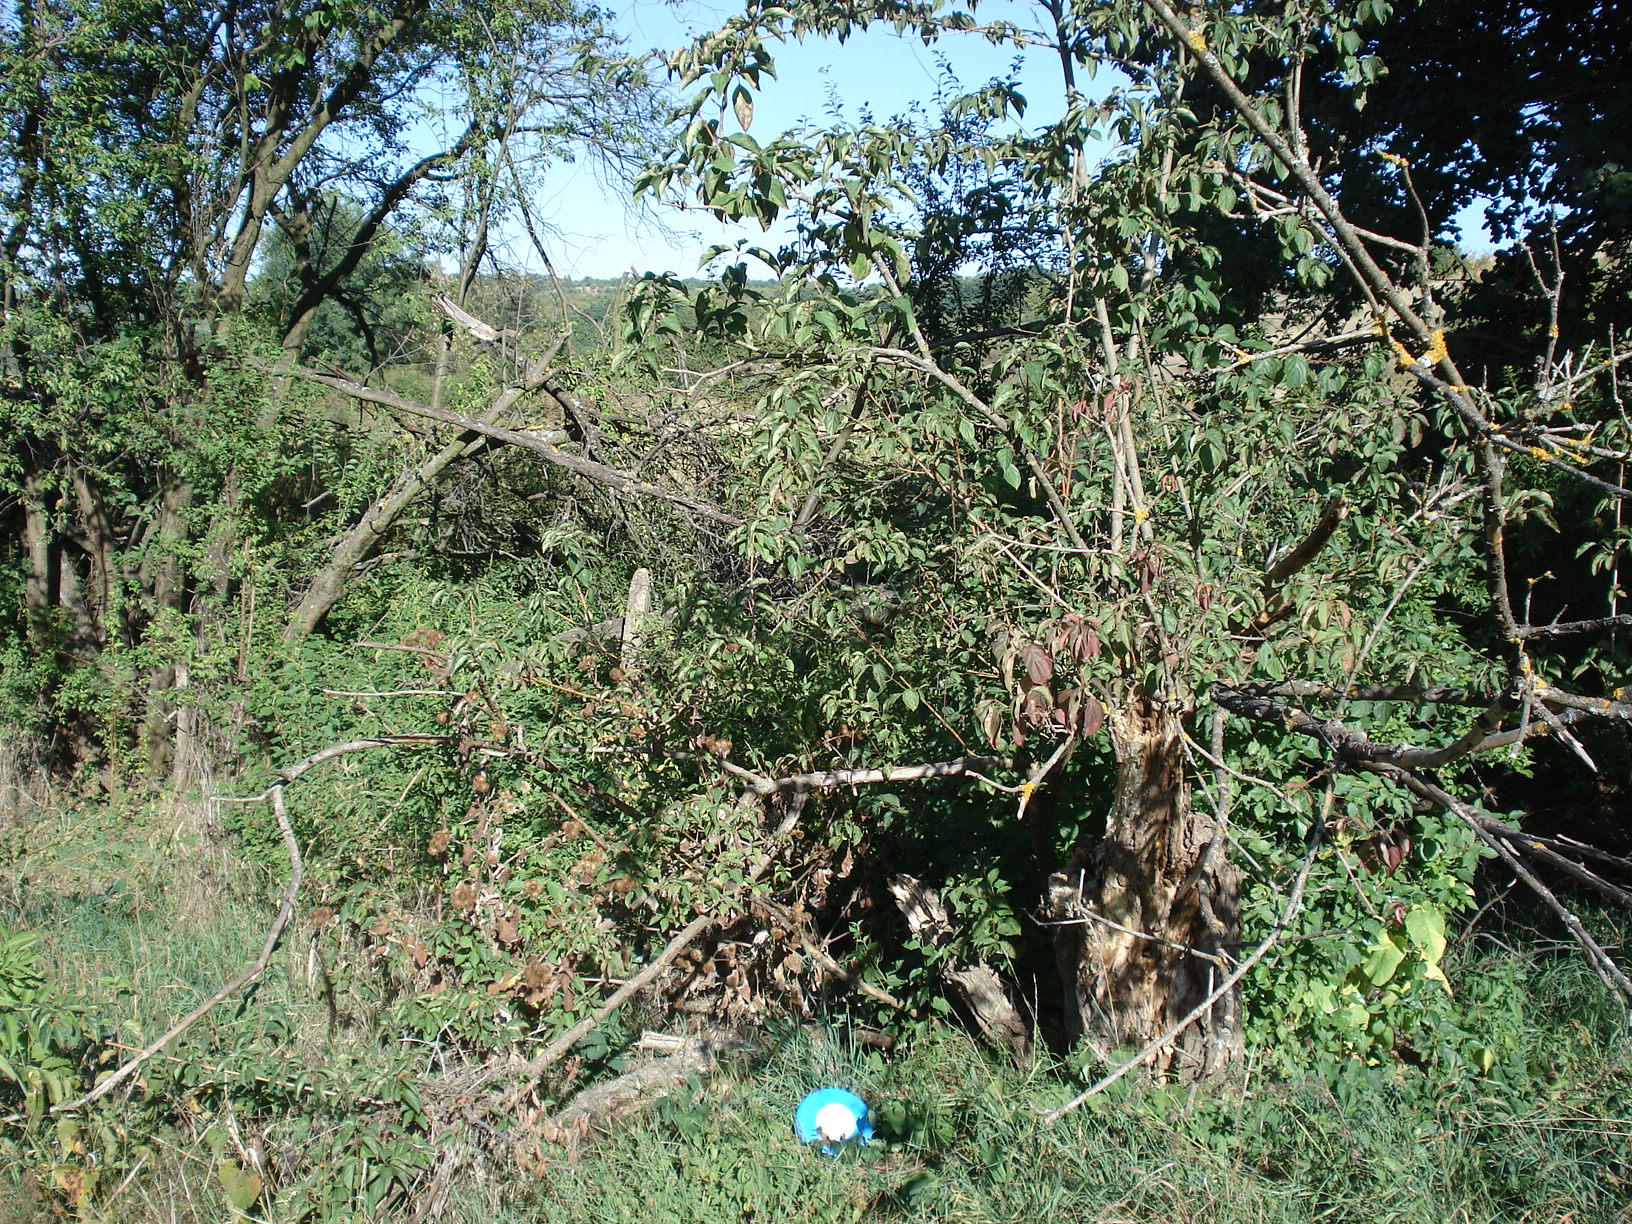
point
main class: Woodland
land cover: Broadleaved woodland
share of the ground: 50 - 75 %
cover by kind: broadleaved forest trees 65 %, herbaceous plants 30 %, shrubs 5 %
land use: Semi-natural and natural areas not in use
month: September
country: BG
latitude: 43.0978
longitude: 25.4210
